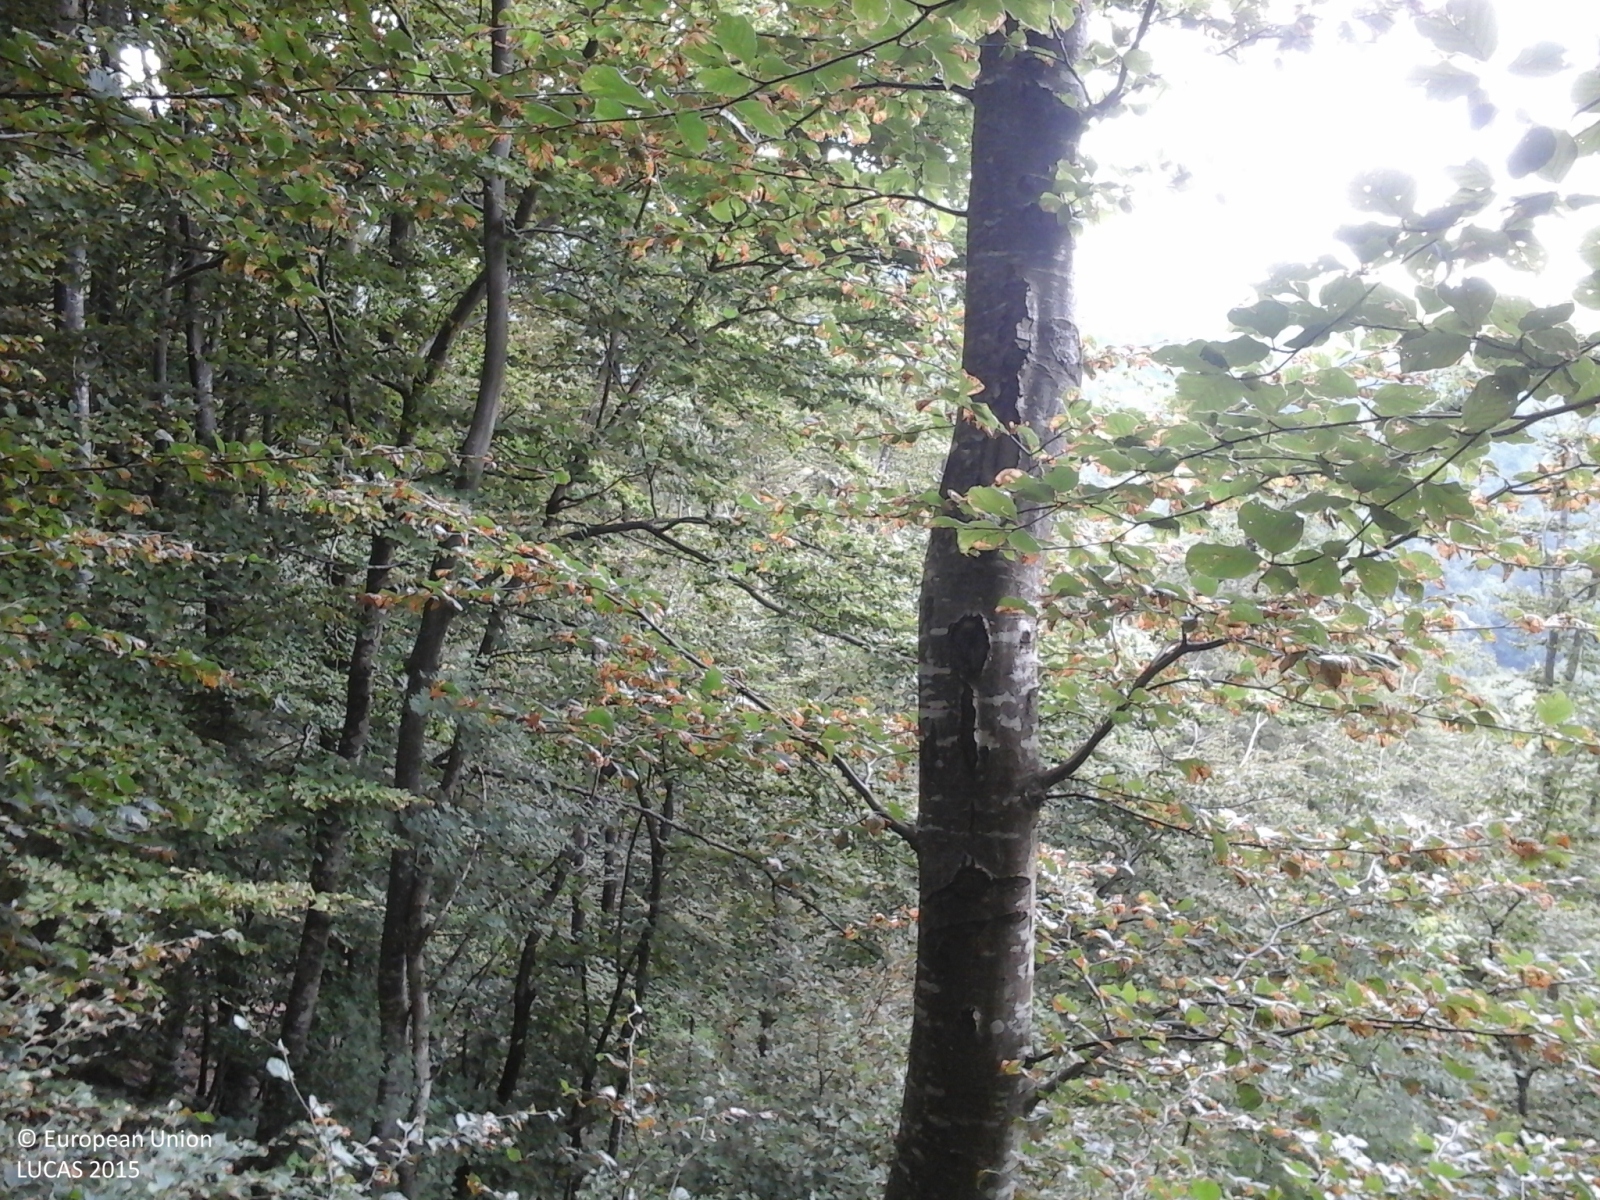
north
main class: Woodland
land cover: Broadleaved woodland
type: thermophilous deciduous forest
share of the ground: > 75 %
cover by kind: broadleaved forest trees 100 %
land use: Forestry
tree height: > 5 m
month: June
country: IT
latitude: 44.5660
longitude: 9.5603
